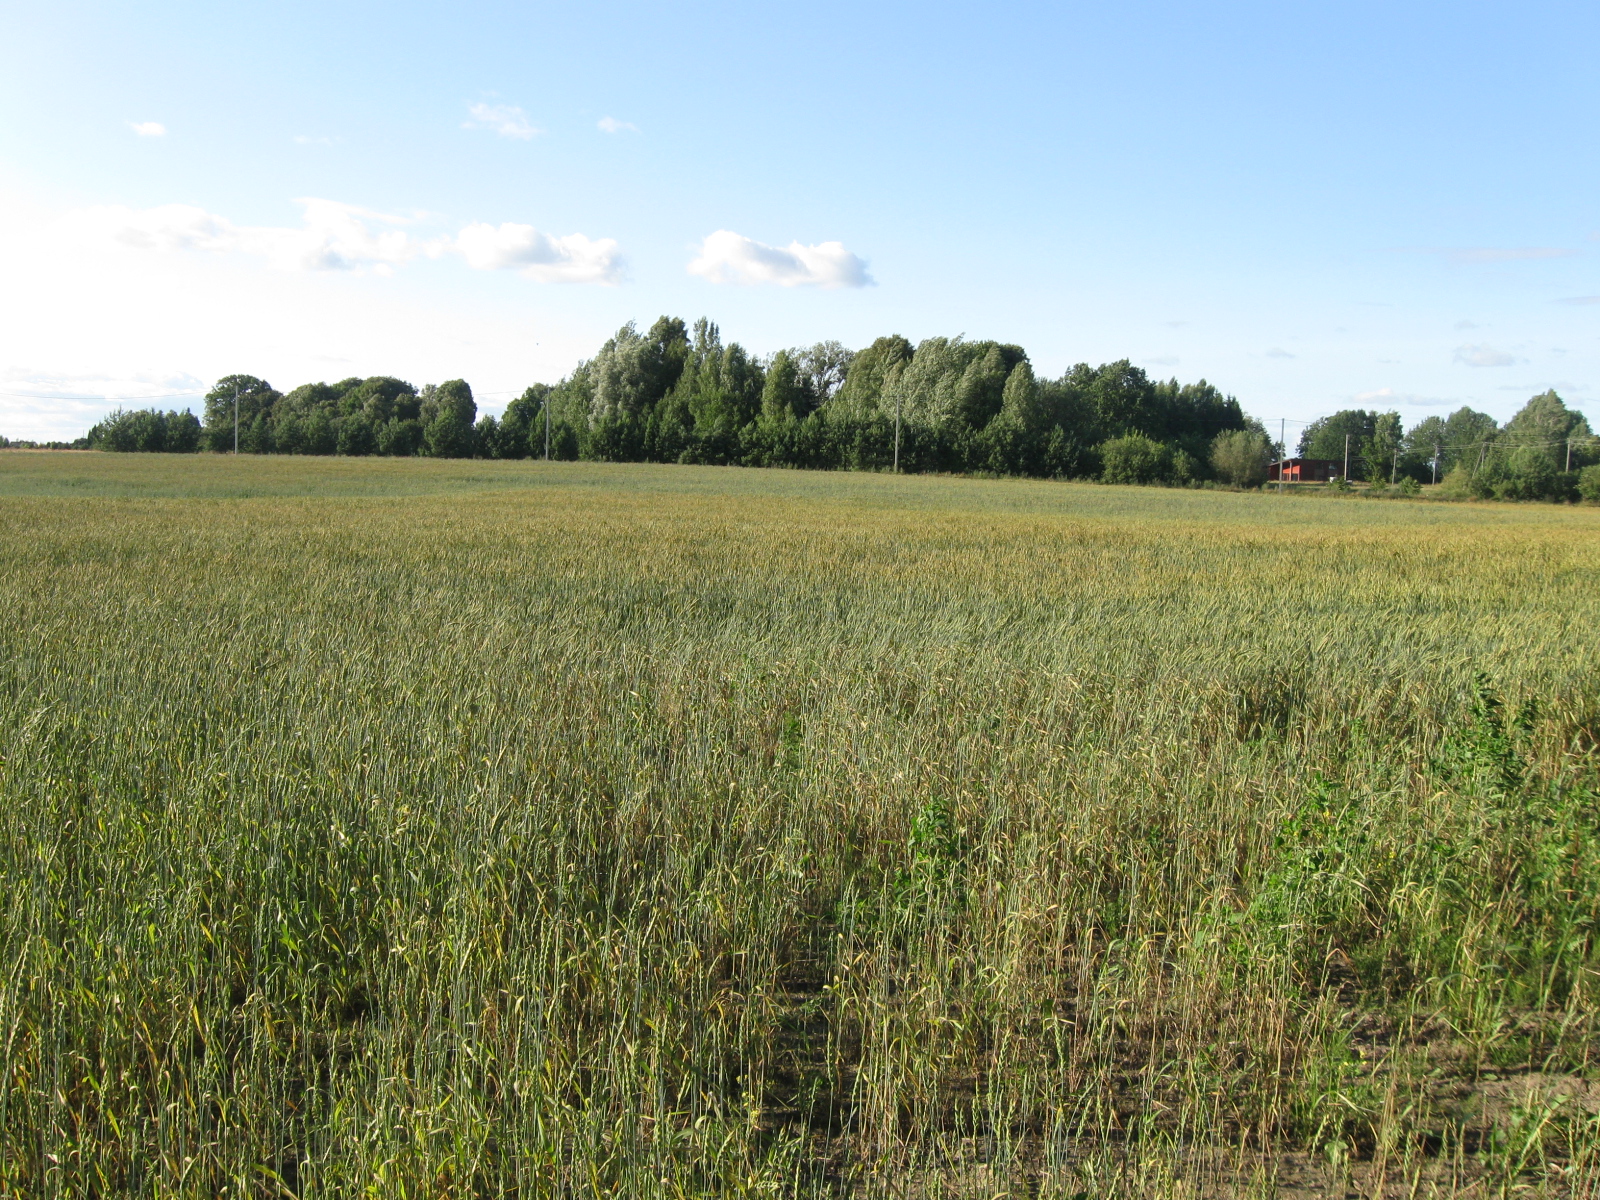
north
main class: Cropland
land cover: Common wheat
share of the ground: > 75 %
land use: Agriculture (excluding fallow land and kitchen gardens)
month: July
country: LT
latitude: 54.8726
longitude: 23.7846
